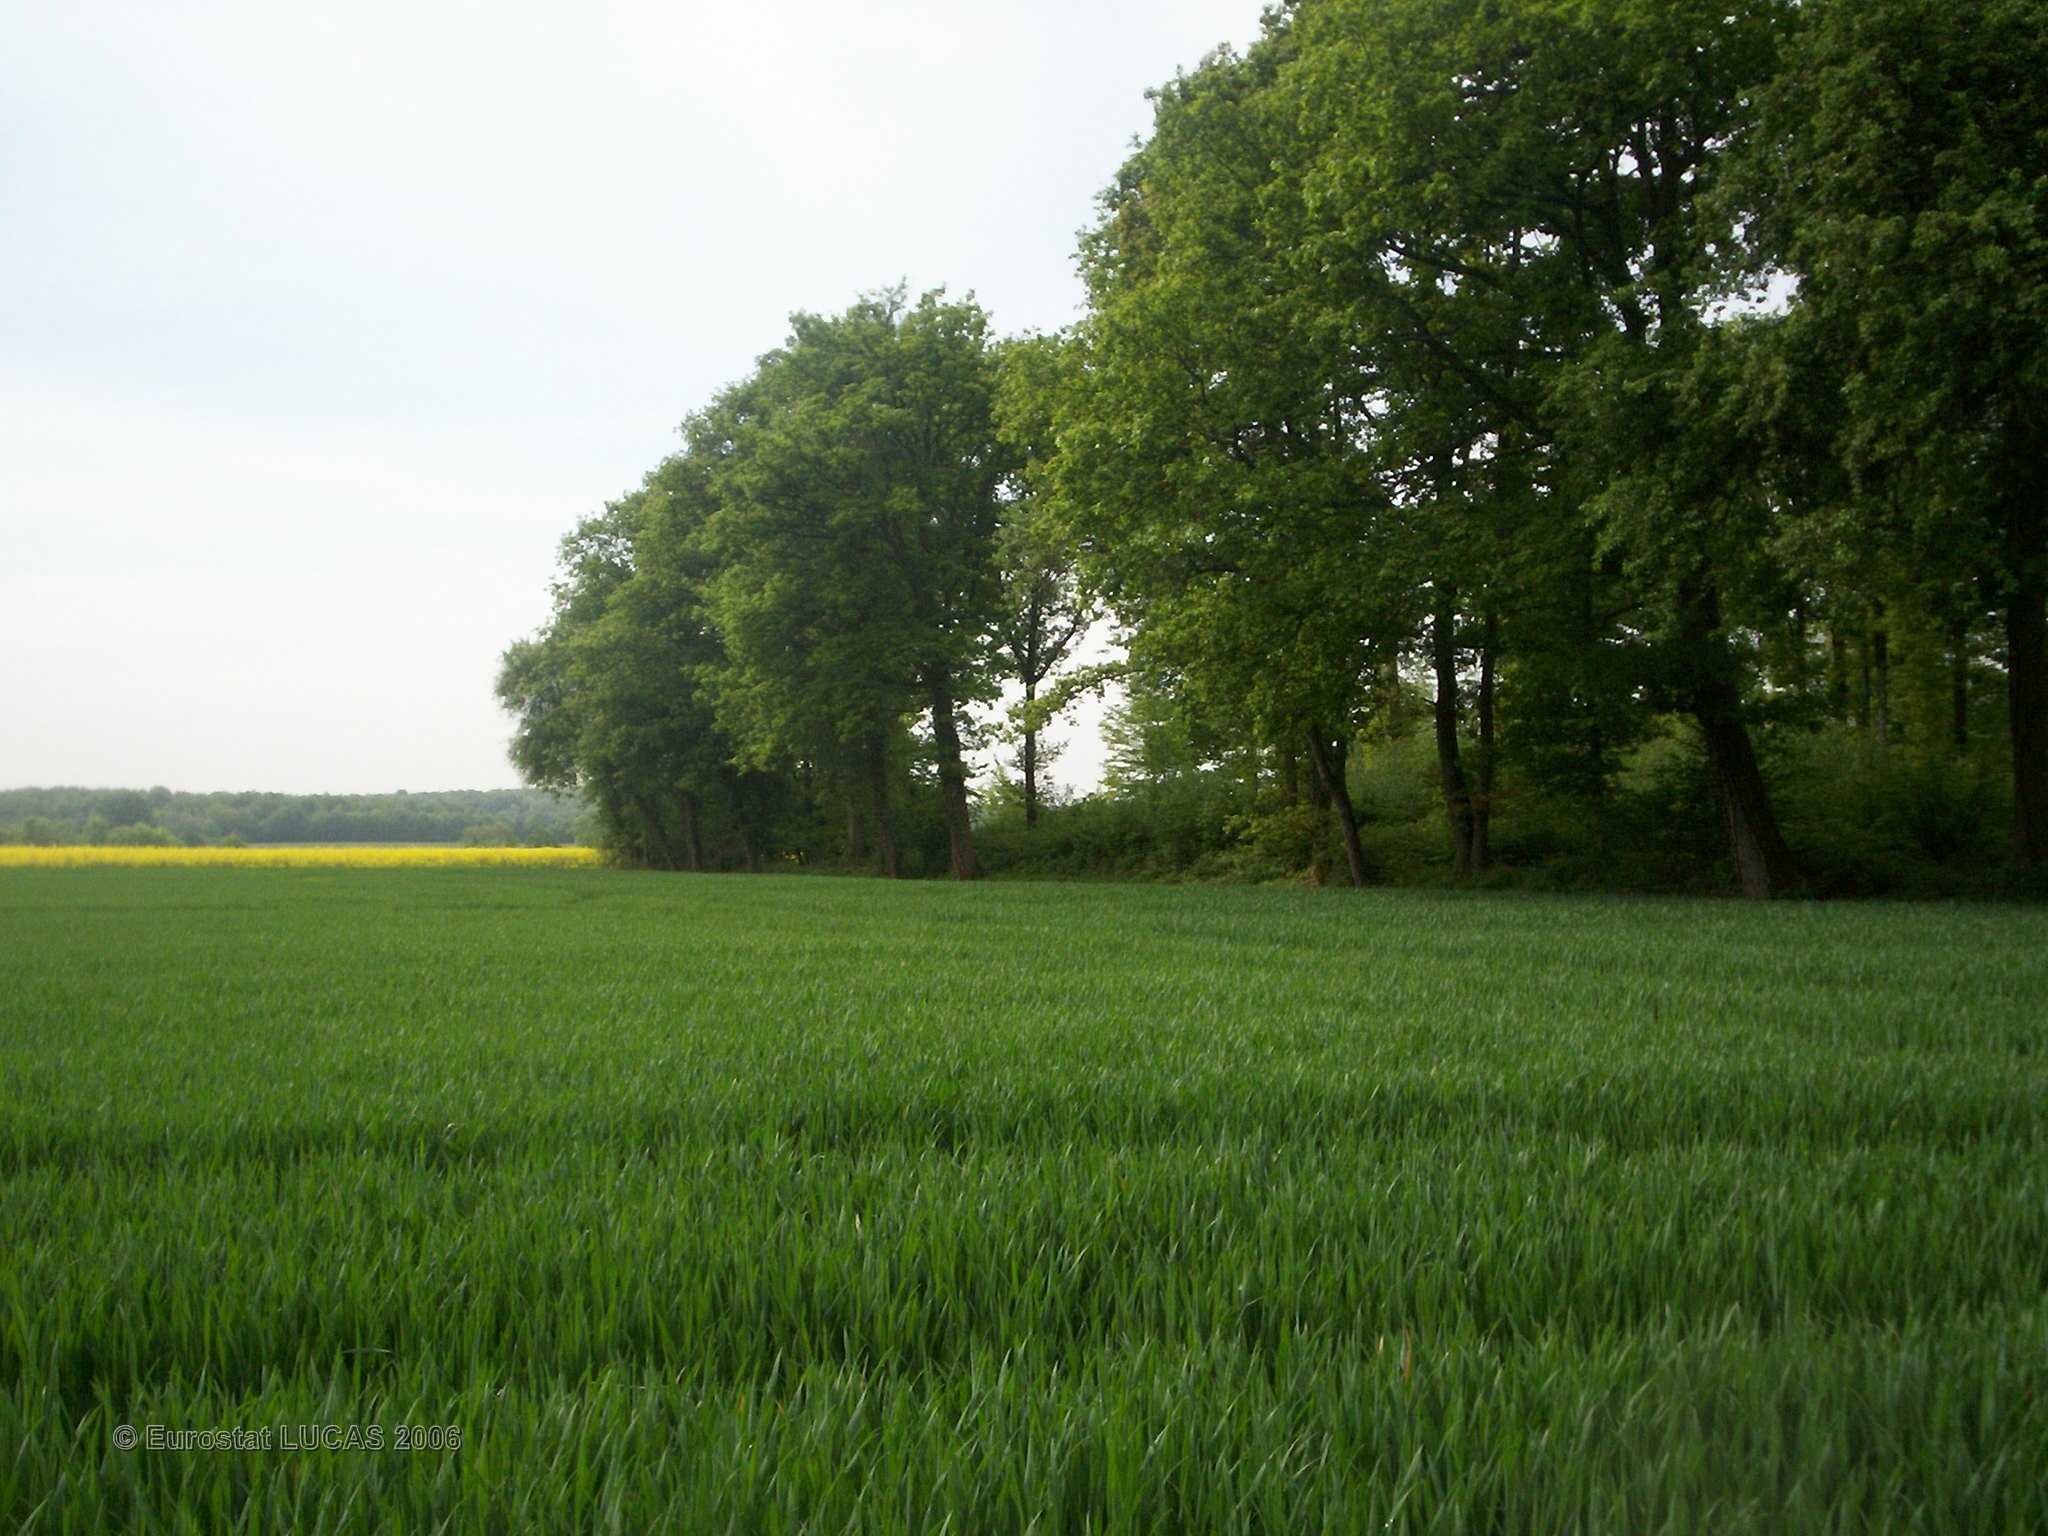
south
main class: Cropland
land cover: Barley
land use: Agriculture (excluding fallow land and kitchen gardens)
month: May
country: FR
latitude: 47.7475
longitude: 2.9912
